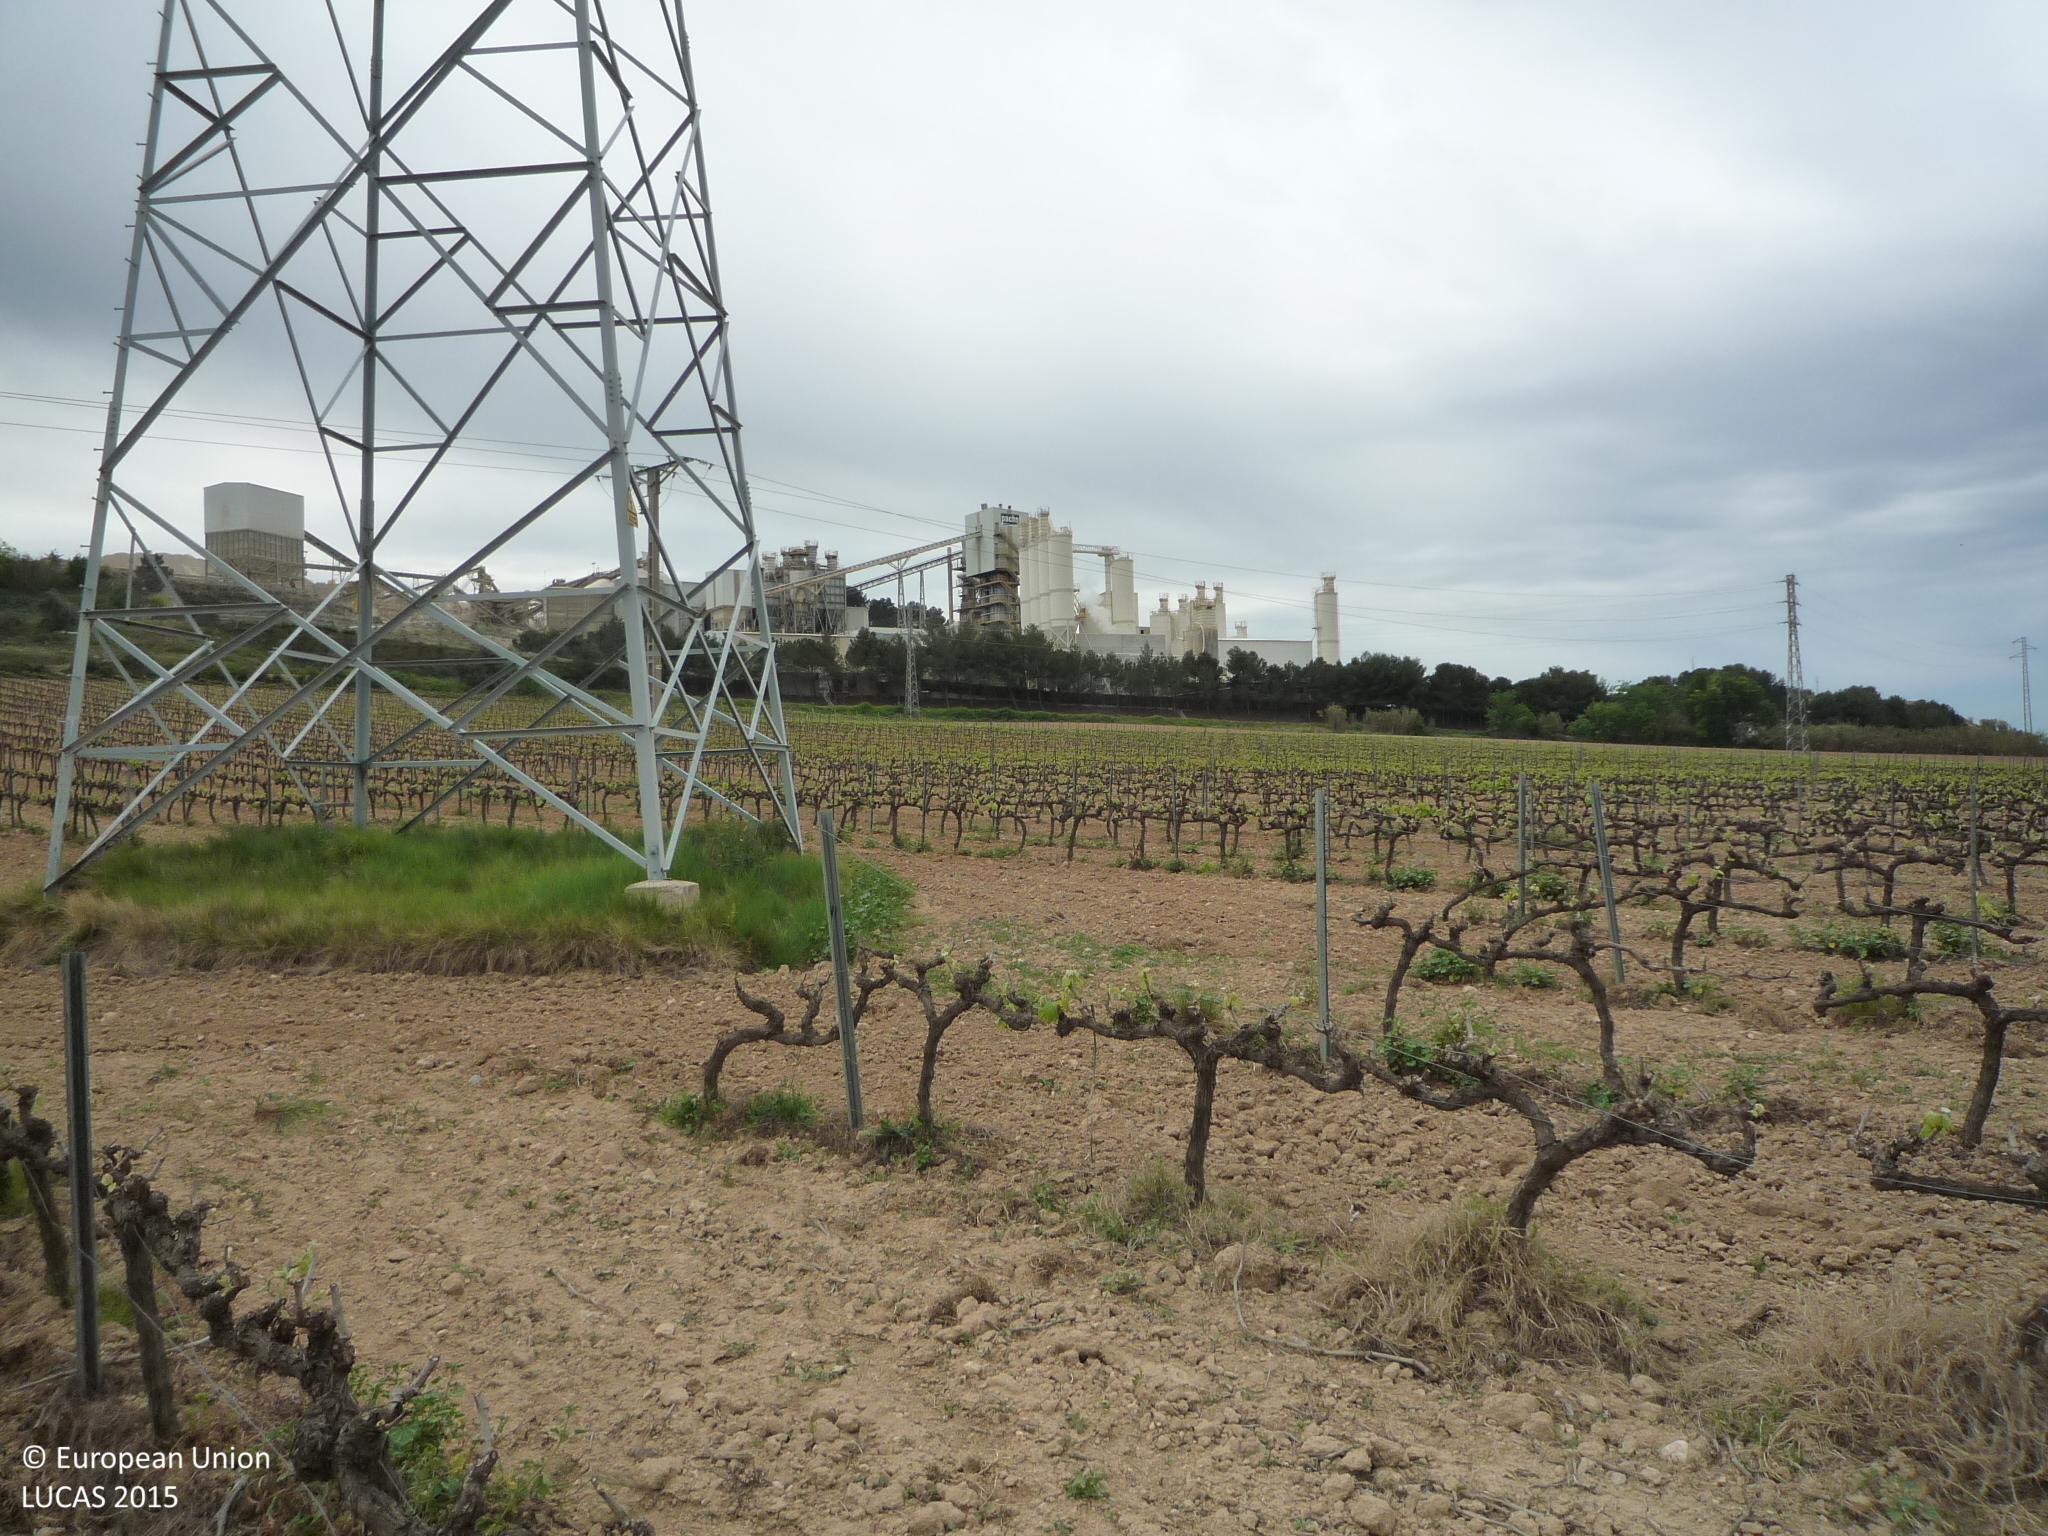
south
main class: Cropland
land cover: Vineyards
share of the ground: 10 - 25 %
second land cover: Other bare soil
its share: > 75 %
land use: Agriculture (excluding fallow land and kitchen gardens)
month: April
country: ES
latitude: 41.3676
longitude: 1.6845
